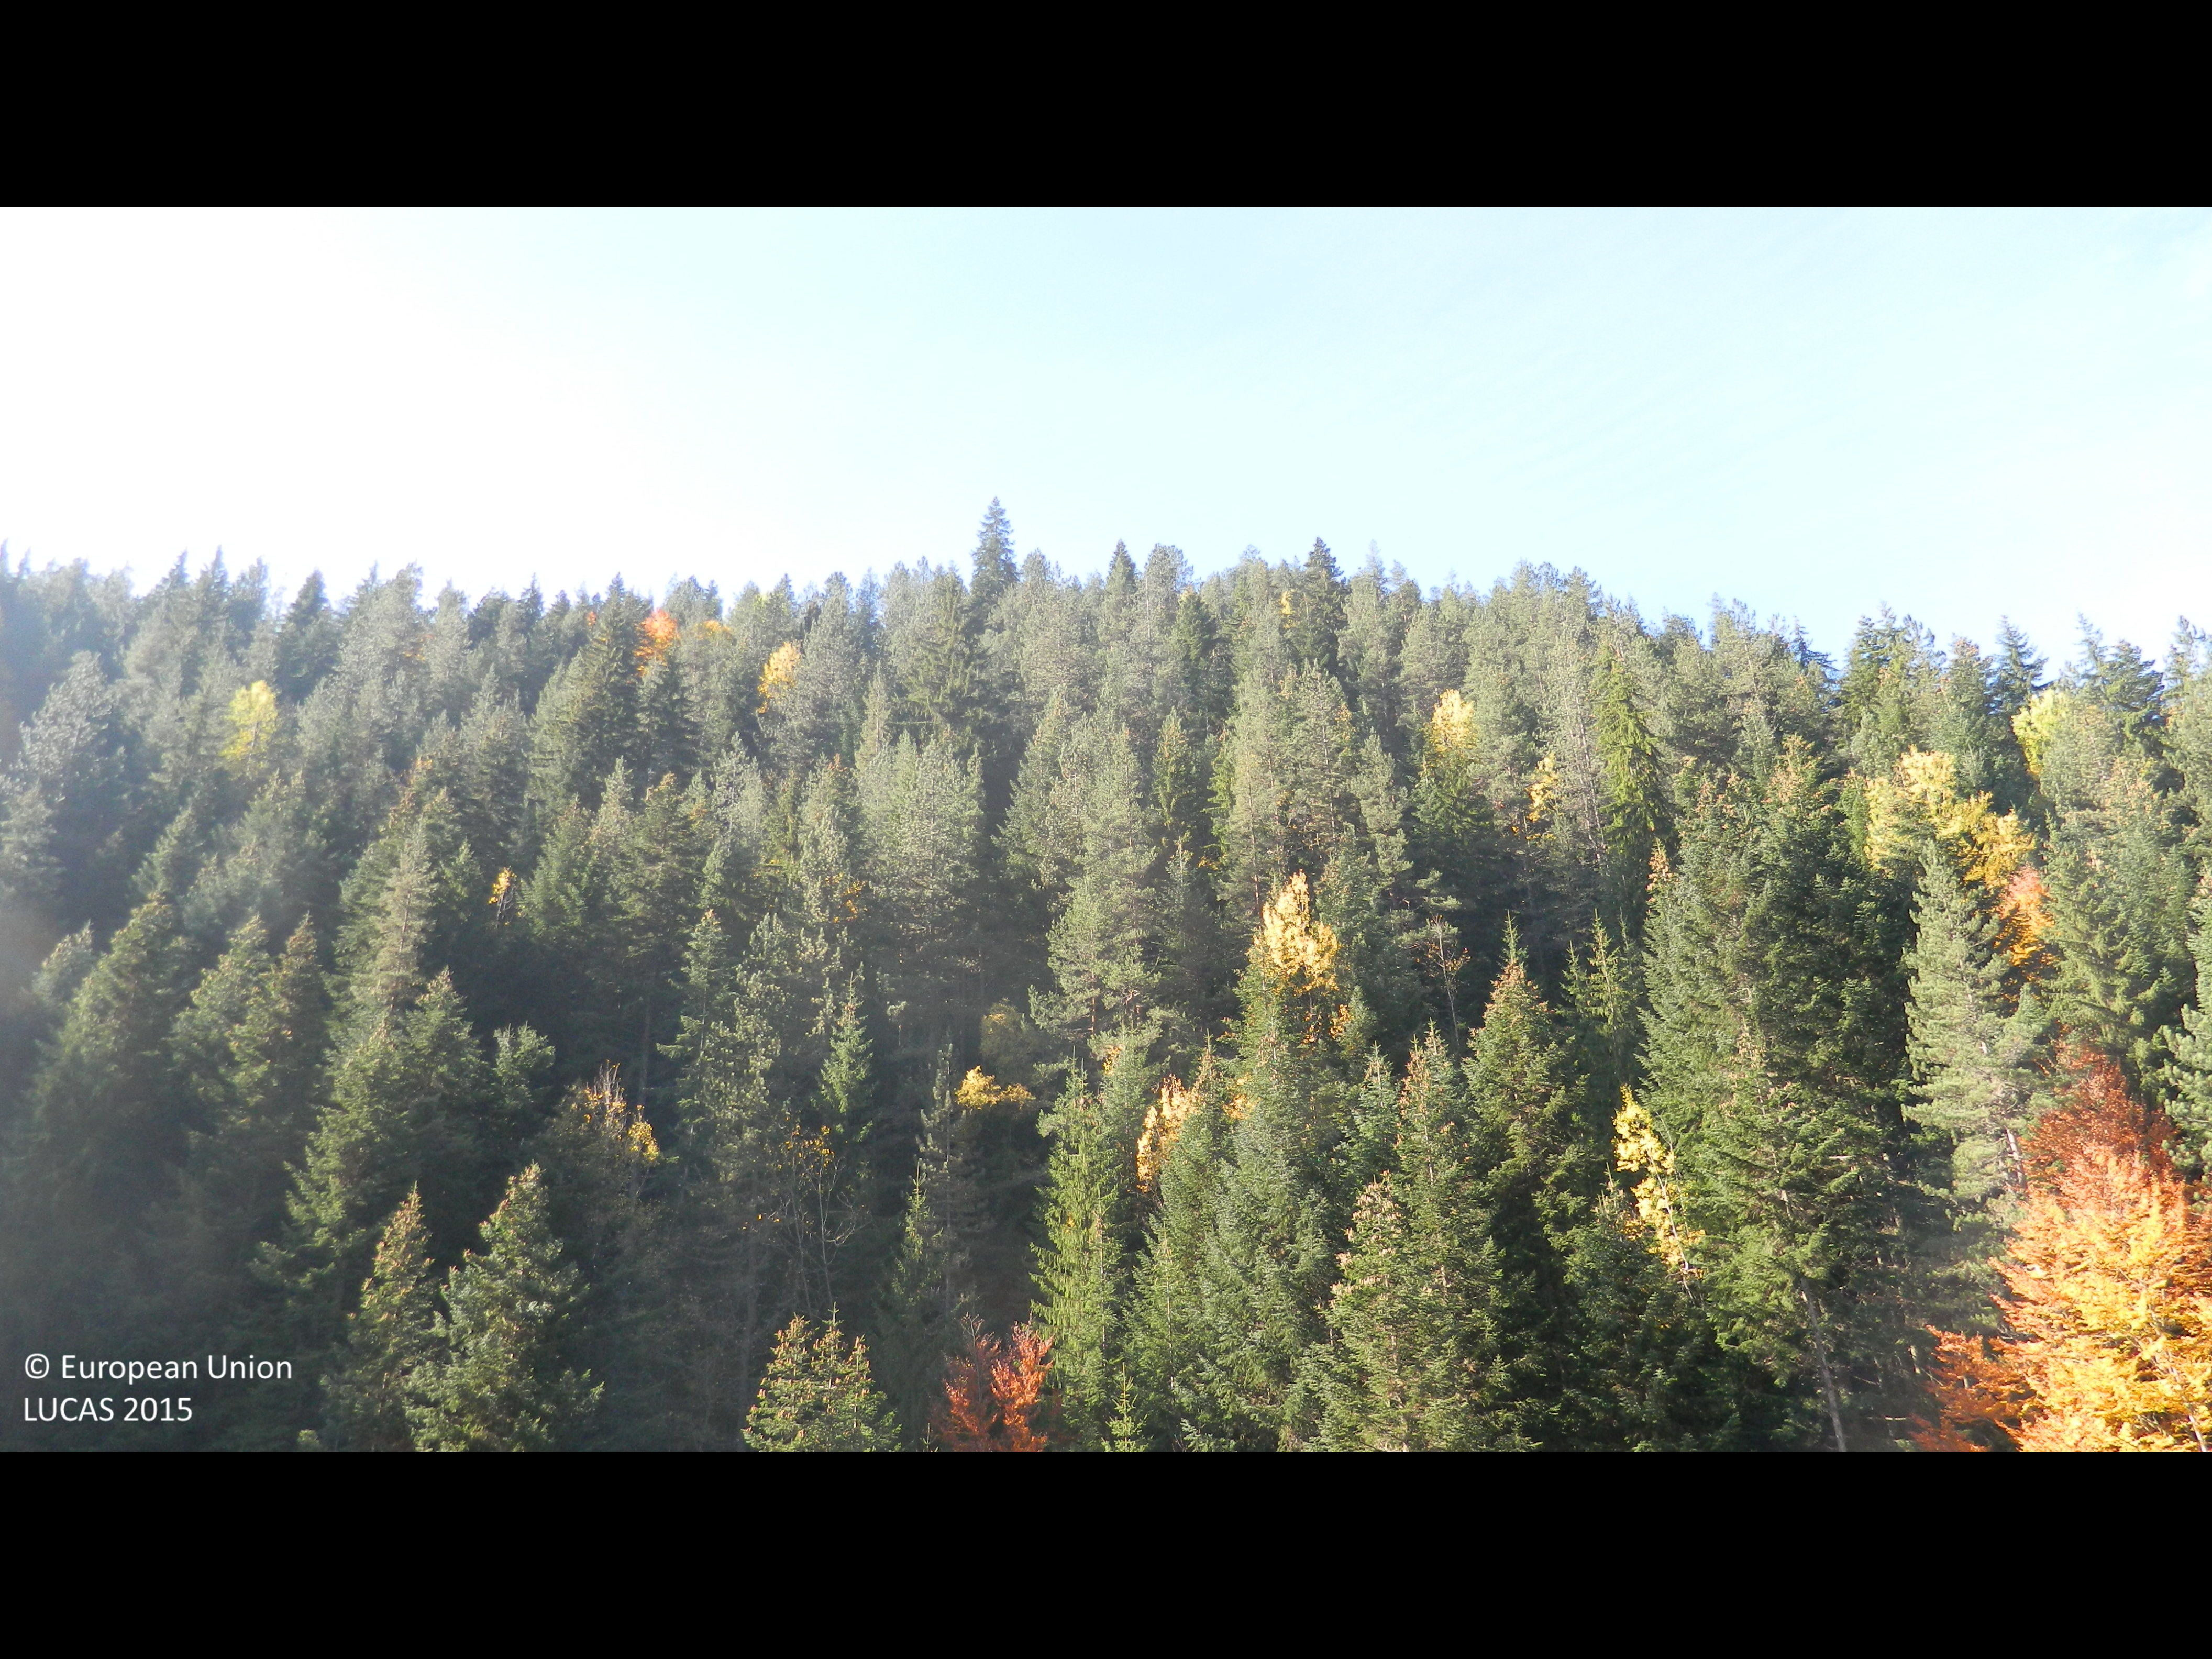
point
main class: Woodland
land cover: Spruce dominated coniferous woodland
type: alpine coniferous forest
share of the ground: > 75 %
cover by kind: coniferous forest trees 100 %
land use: Forestry
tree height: > 5 m
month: October
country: BG
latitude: 41.6467
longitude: 24.4605
